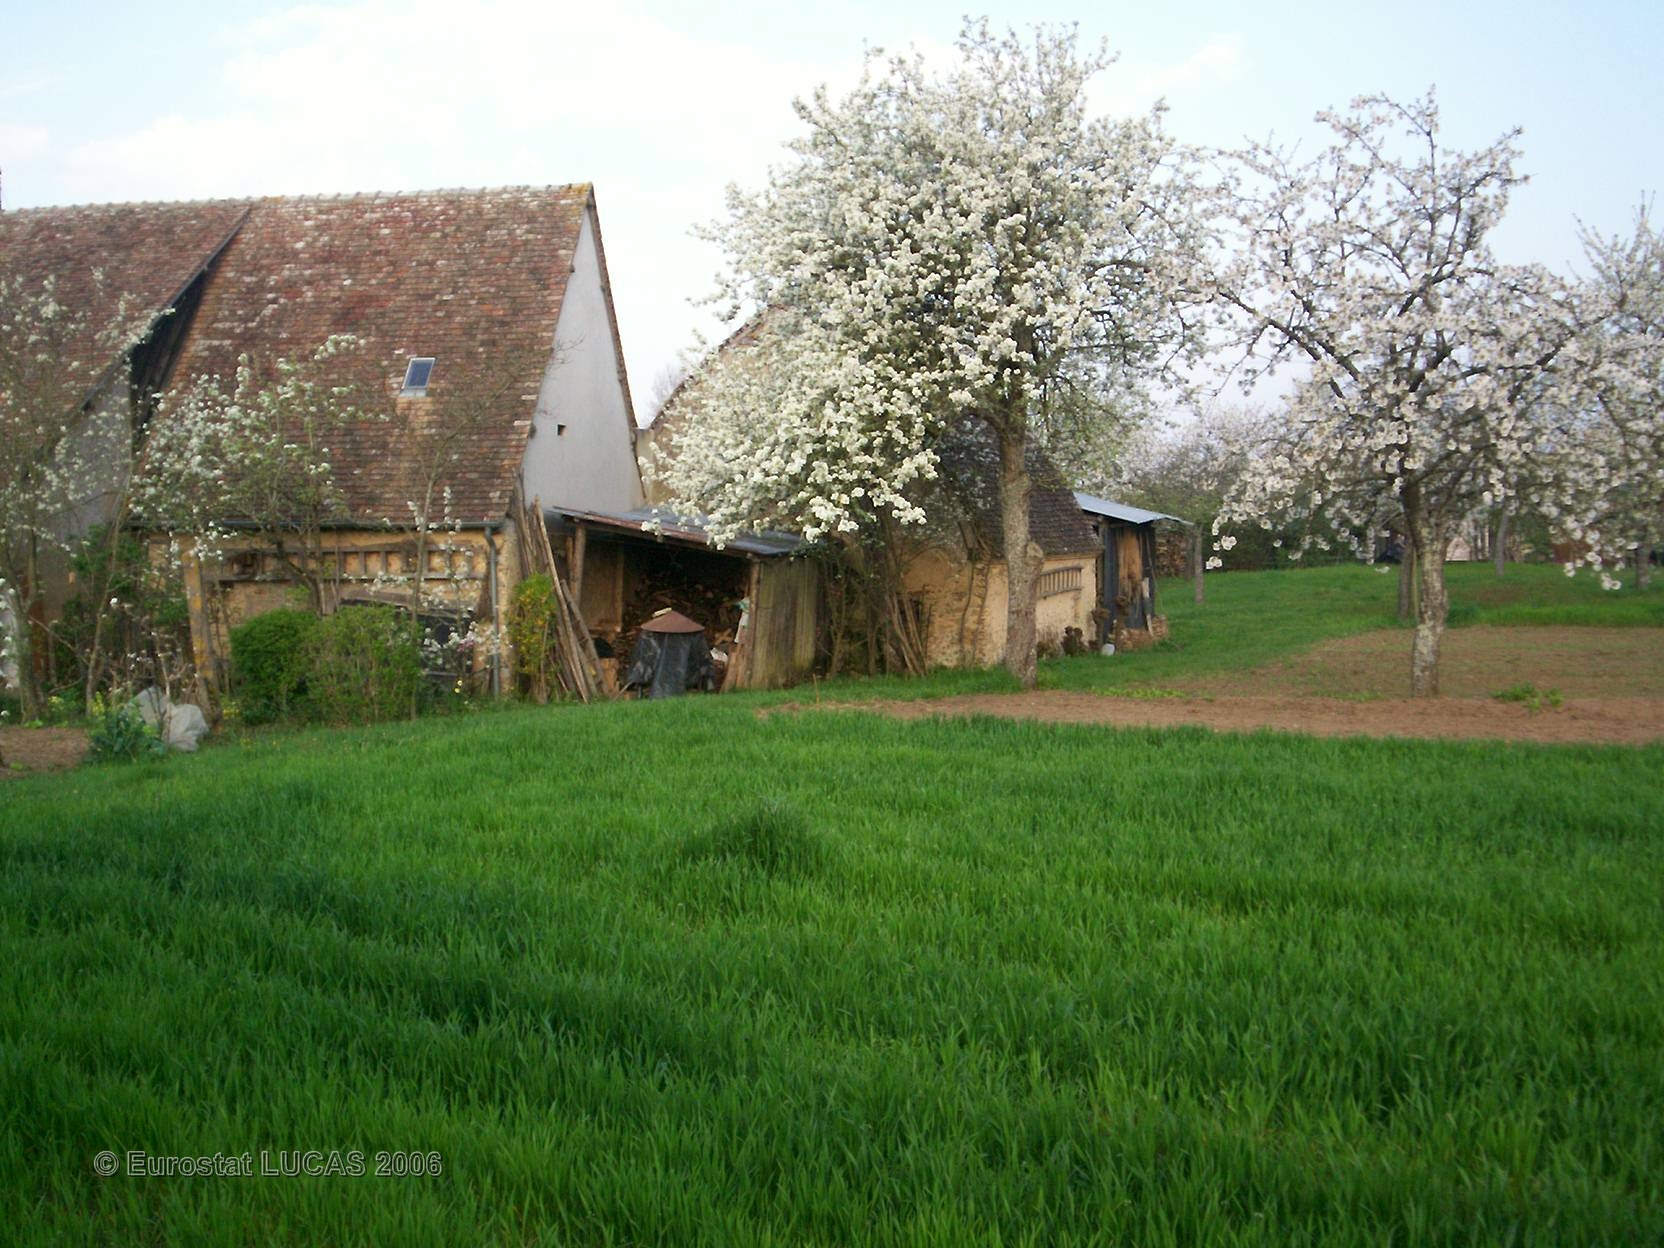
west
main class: Cropland
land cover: Common wheat
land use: Agriculture (excluding fallow land and kitchen gardens)
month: April
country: FR
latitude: 48.1449
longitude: 0.3653
